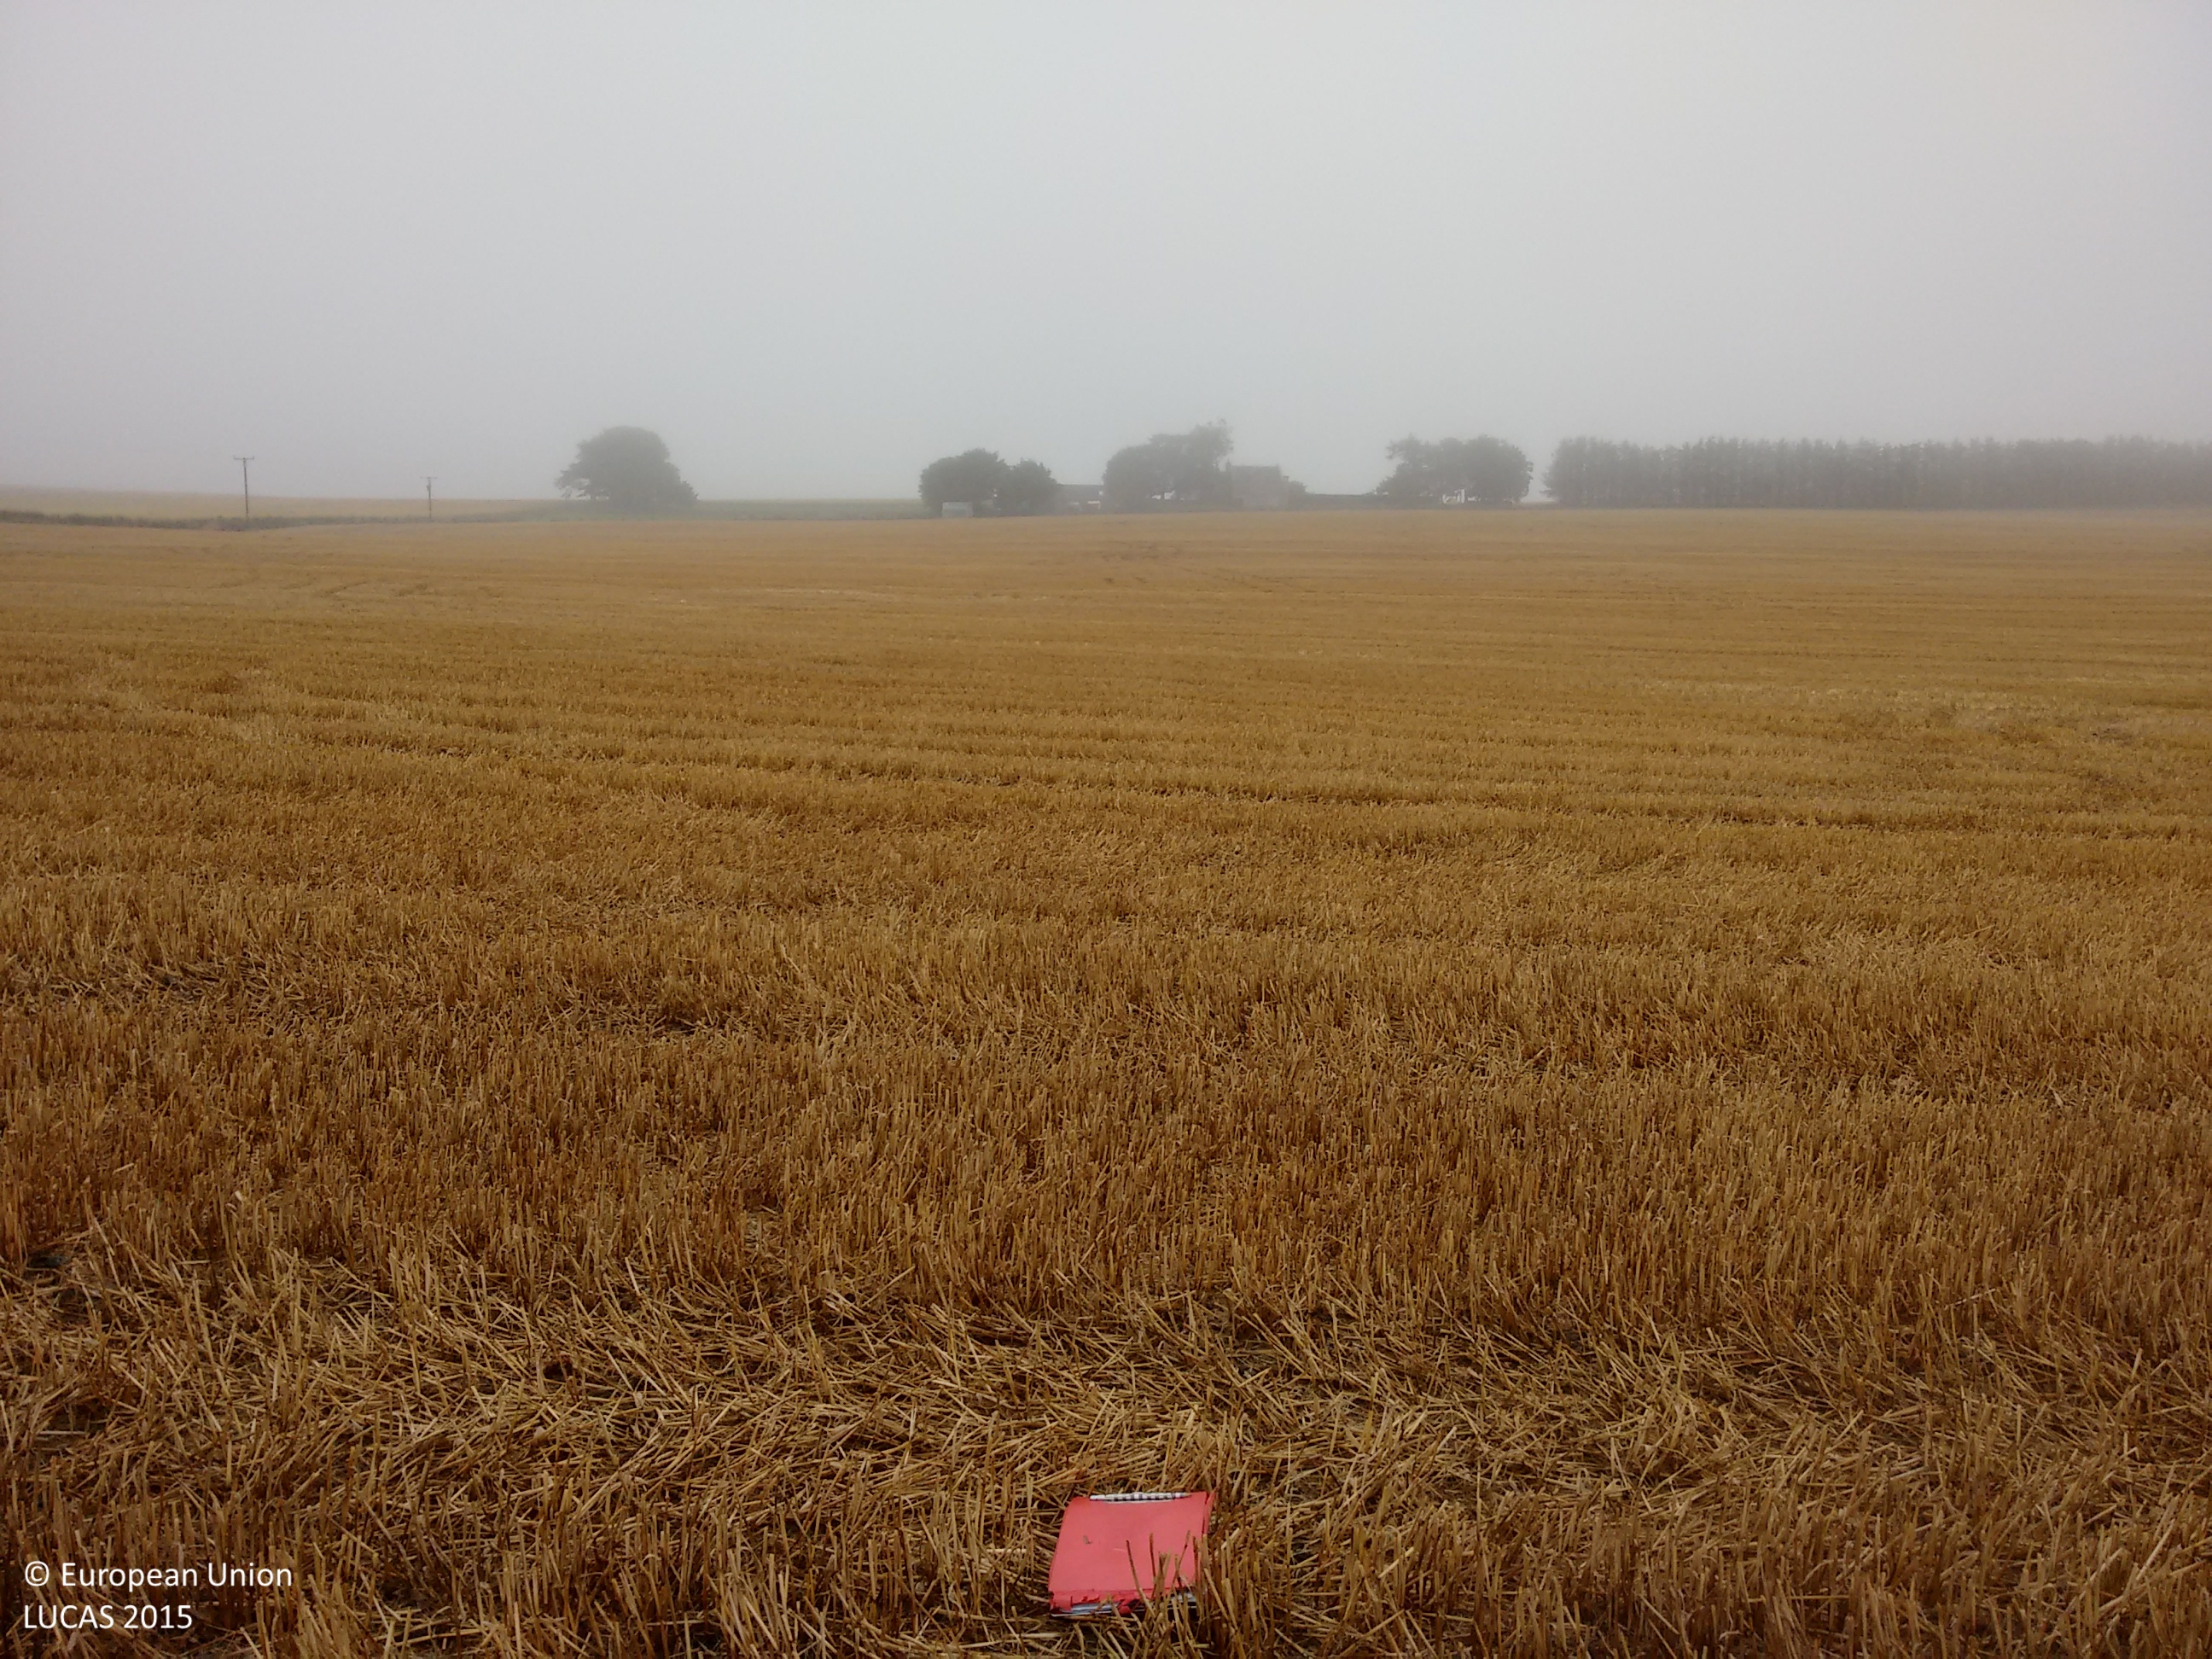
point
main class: Cropland
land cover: Barley
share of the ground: > 75 %
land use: Agriculture (excluding fallow land and kitchen gardens)
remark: Harvested field
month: August
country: GB
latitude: 57.4107
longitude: -2.1498
